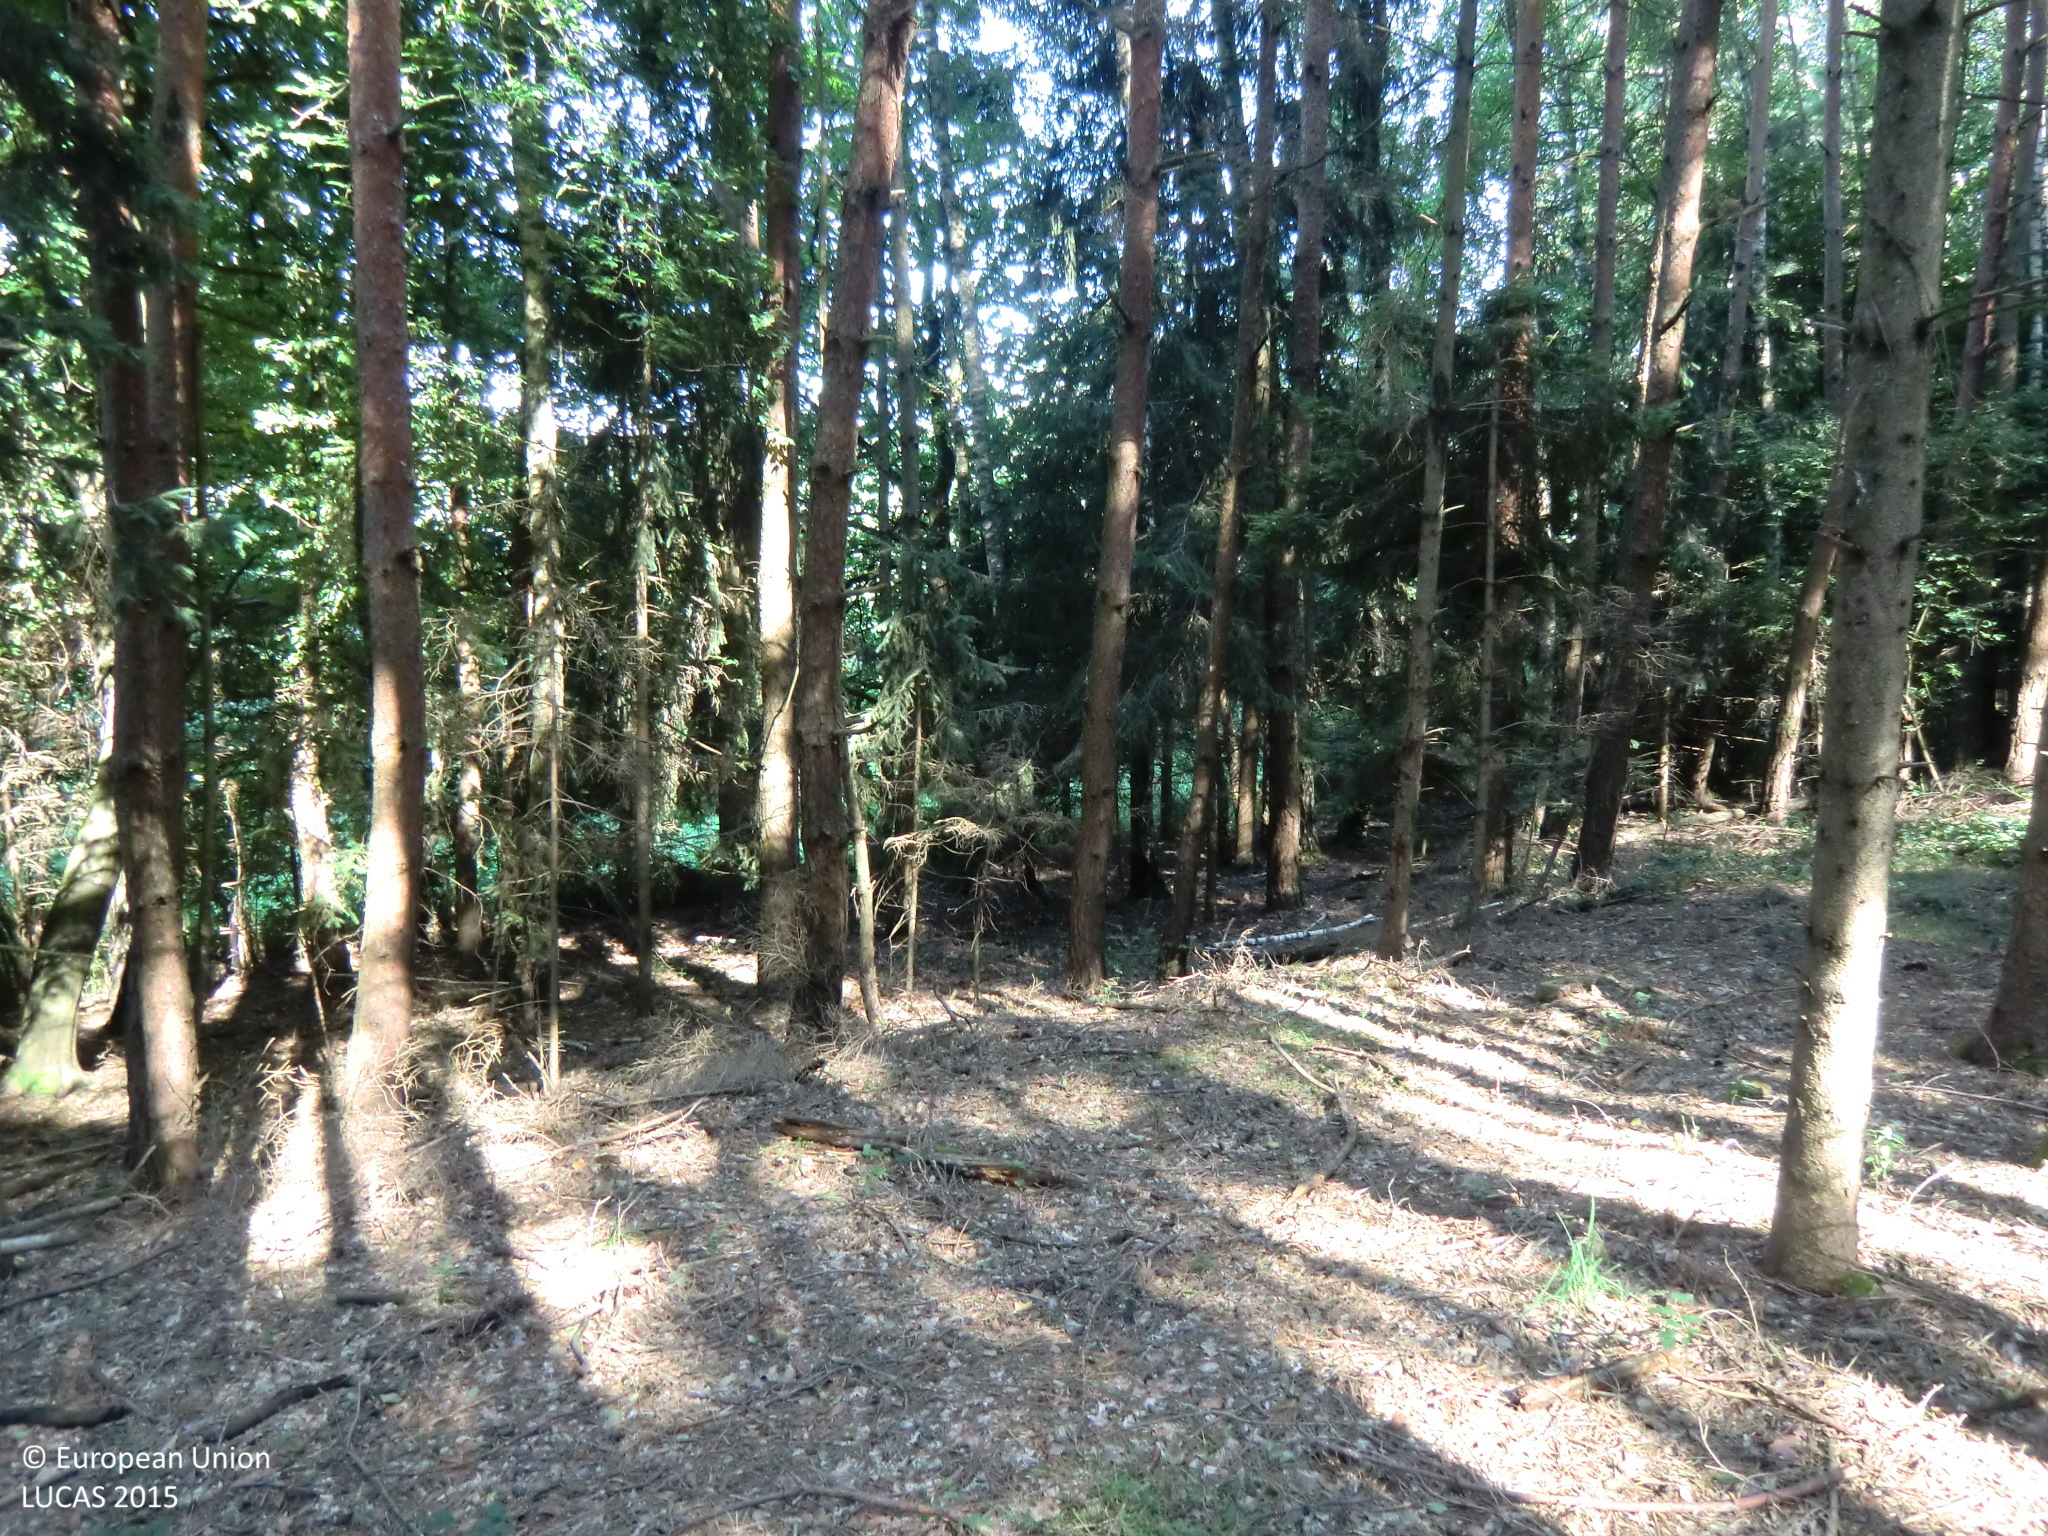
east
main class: Woodland
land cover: Spruce dominated coniferous woodland
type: hemiboreal forest and nemoral coniferous forest and mixed broadleaved-coniferous forest
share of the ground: > 75 %
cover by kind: coniferous forest trees 90 %, unconsolidated bare surface 10 %
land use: Forestry
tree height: > 5 m
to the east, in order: Spruce dominated coniferous woodland; Temporary grasslands; Broadleaved woodland; Grassland without tree/shrub cover; Grassland with sparse tree/shrub cover; Broadleaved woodland; Pine dominated mixed woodland; Spruce dominated mixed woodland; Rivers and streams; Spruce dominated mixed woodland
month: July
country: AT
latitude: 47.0411
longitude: 16.1478
